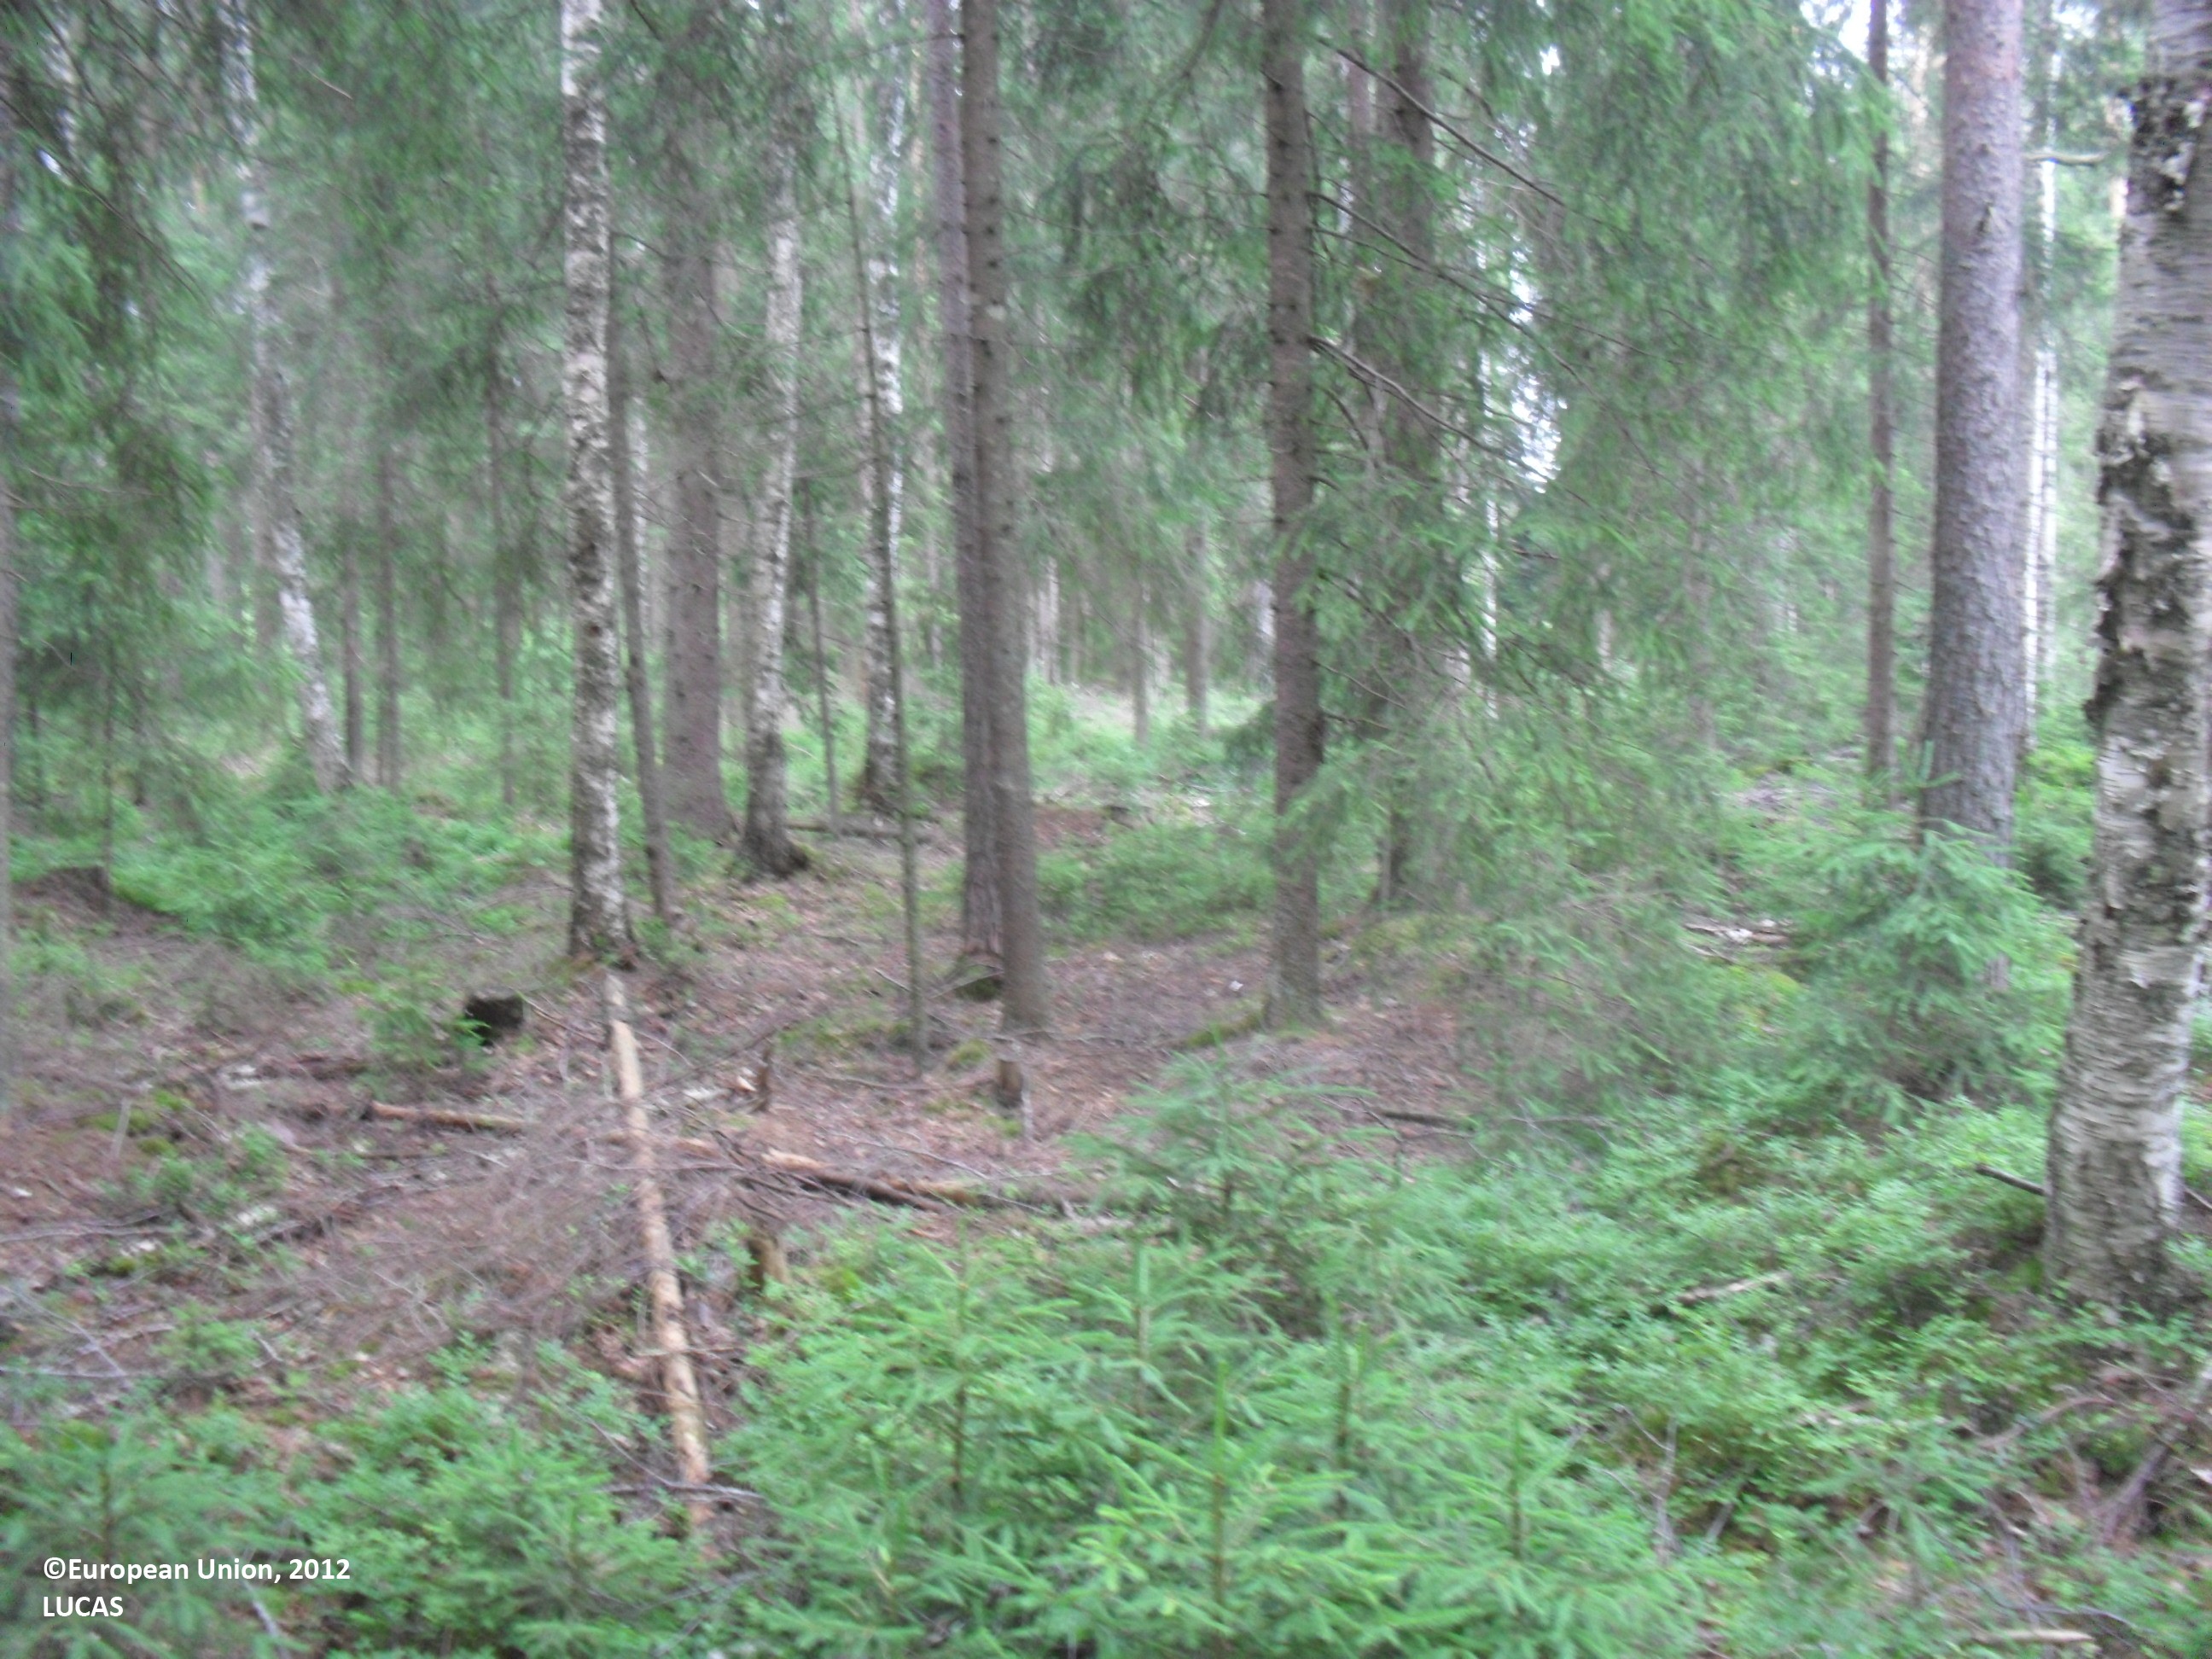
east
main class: Woodland
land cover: Spruce dominated mixed woodland
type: boreal forest
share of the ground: 50 - 75 %
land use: Forestry
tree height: > 5 m
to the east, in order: Spruce dominated mixed woodland; Spruce dominated coniferous woodland; Broadleaved woodland; Pine dominated mixed woodland; Tracks
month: July
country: FI
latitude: 63.6324
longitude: 23.5219
